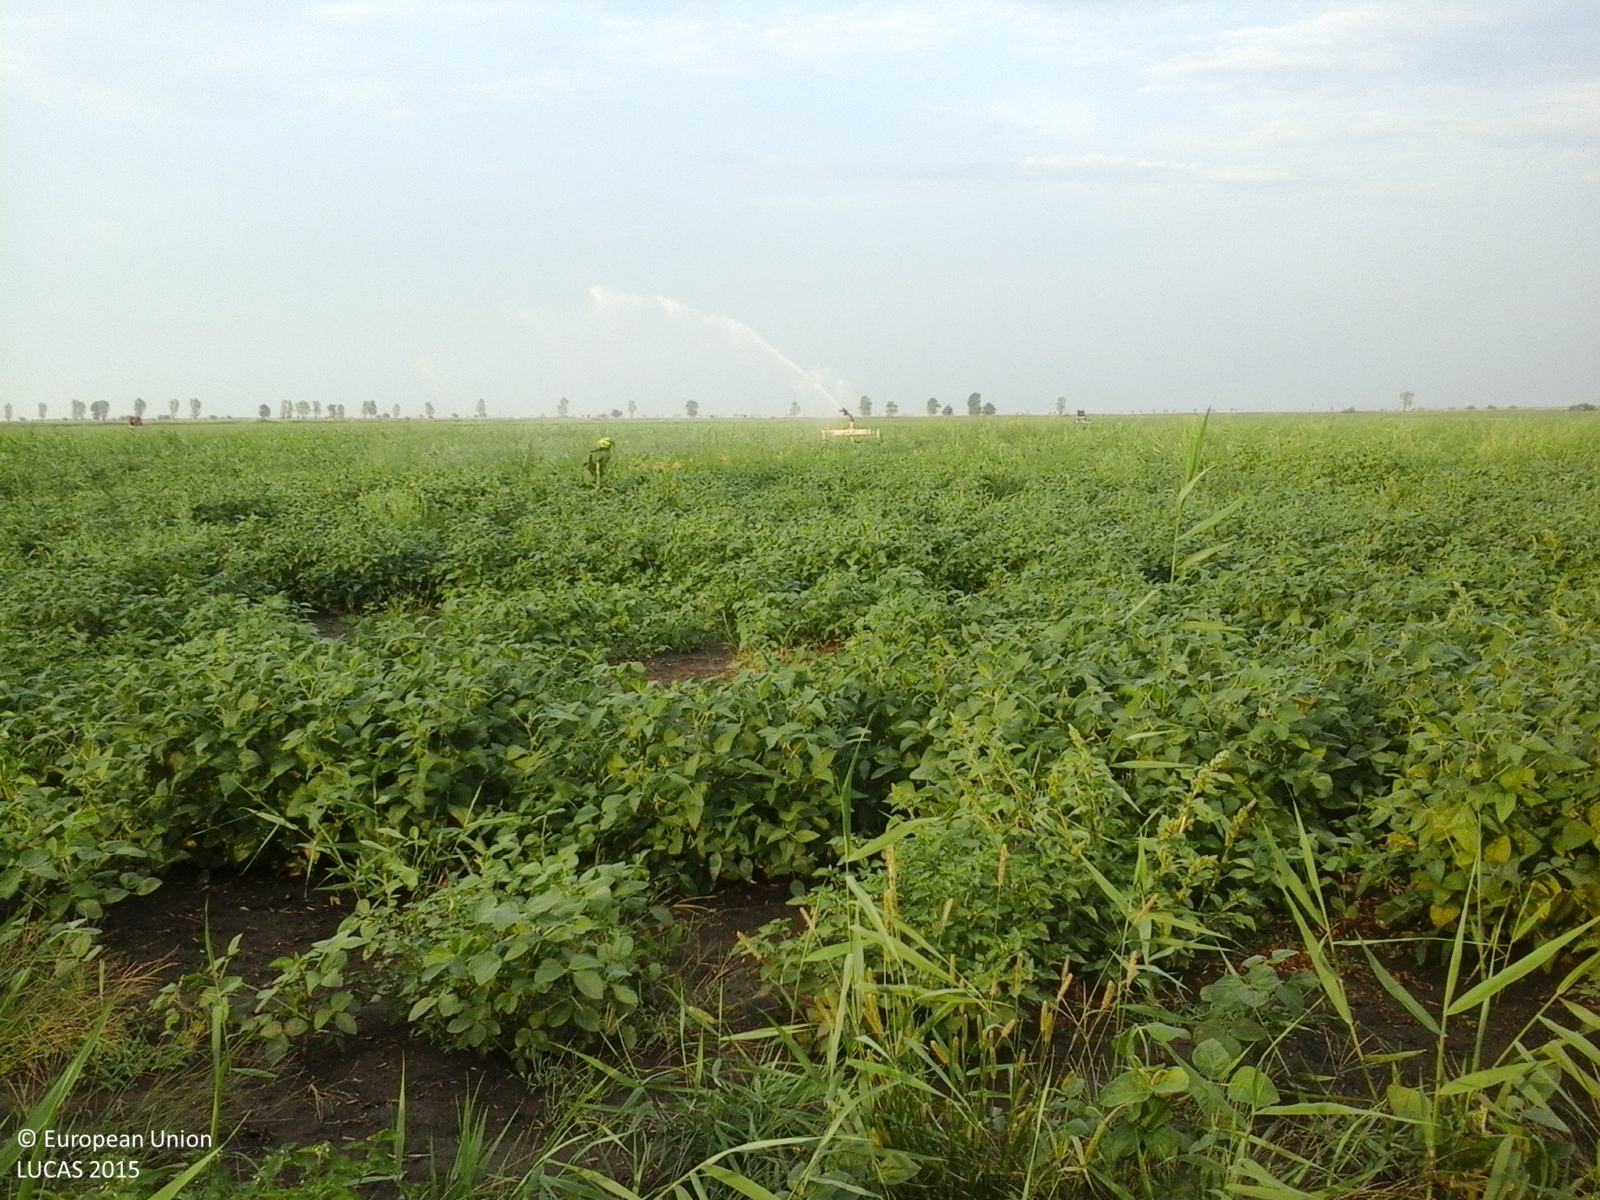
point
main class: Cropland
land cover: Soya
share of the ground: > 75 %
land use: Agriculture (excluding fallow land and kitchen gardens)
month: August
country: RO
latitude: 45.0624
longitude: 27.4836
